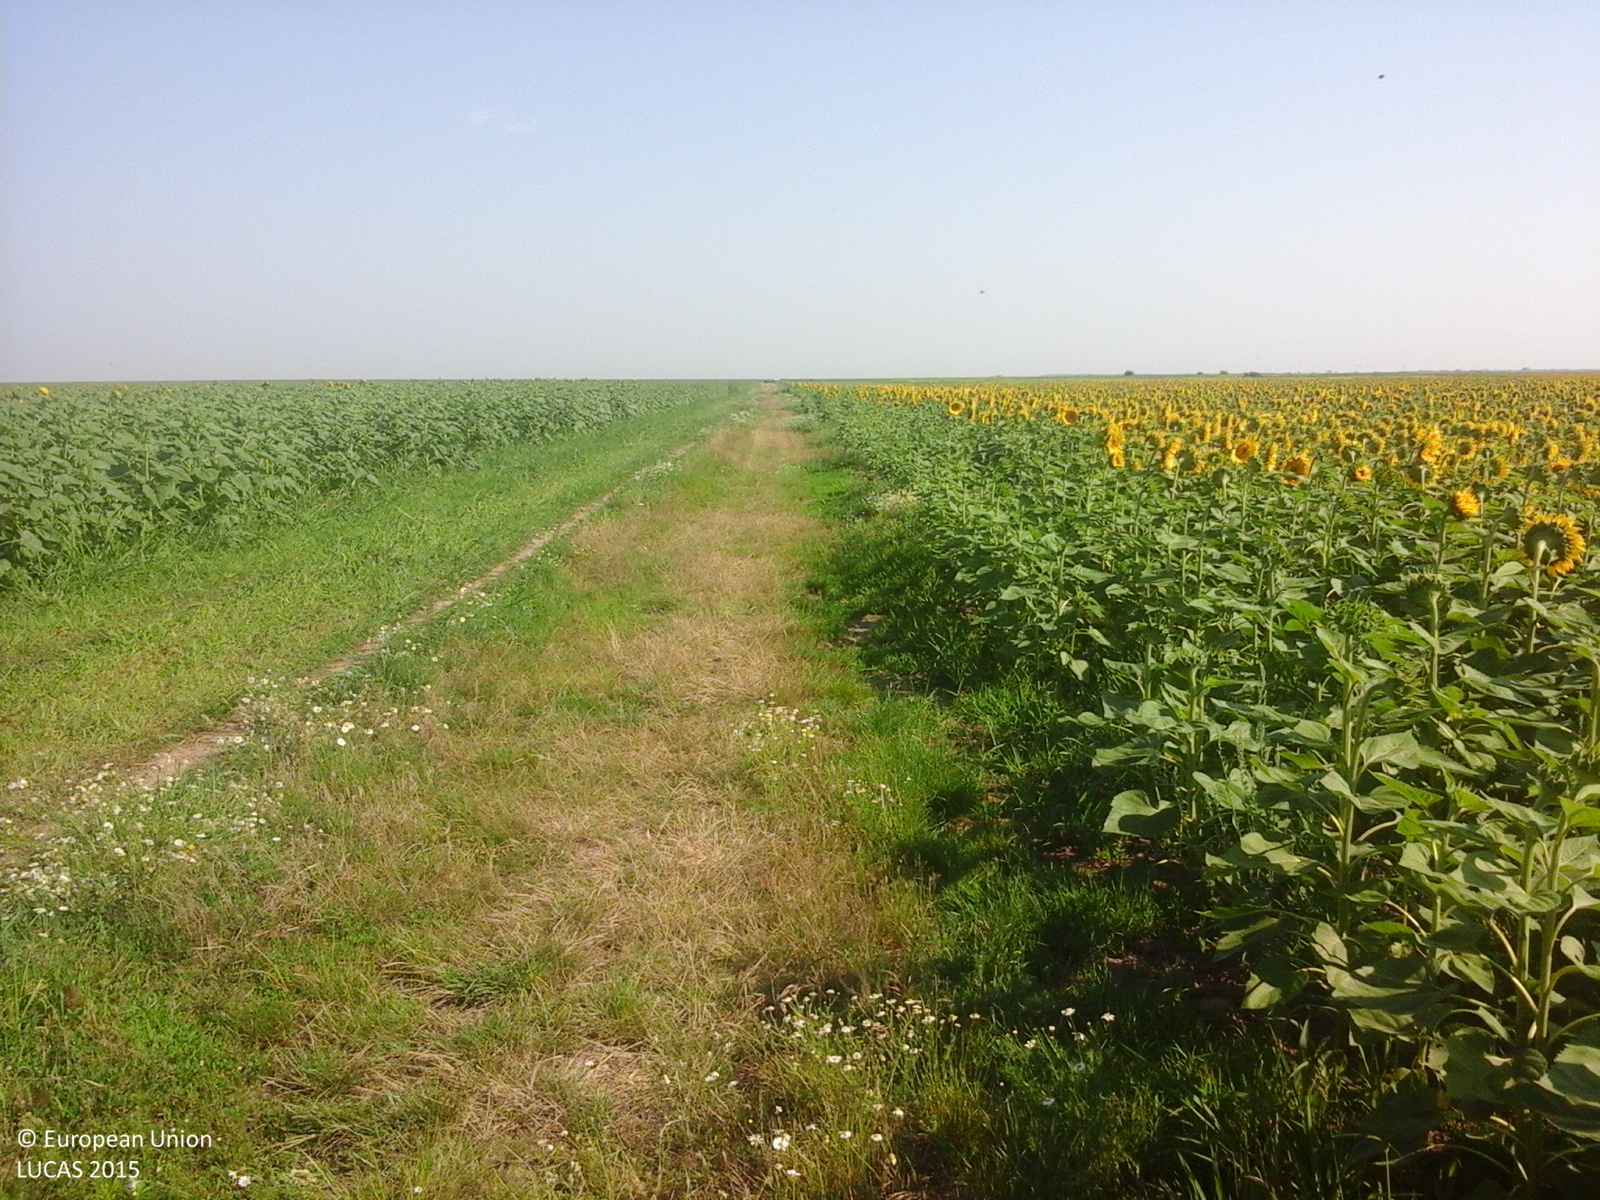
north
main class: Cropland
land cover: Sunflower
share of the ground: > 75 %
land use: Agriculture (excluding fallow land and kitchen gardens)
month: July
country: RO
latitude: 44.1322
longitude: 25.3712
